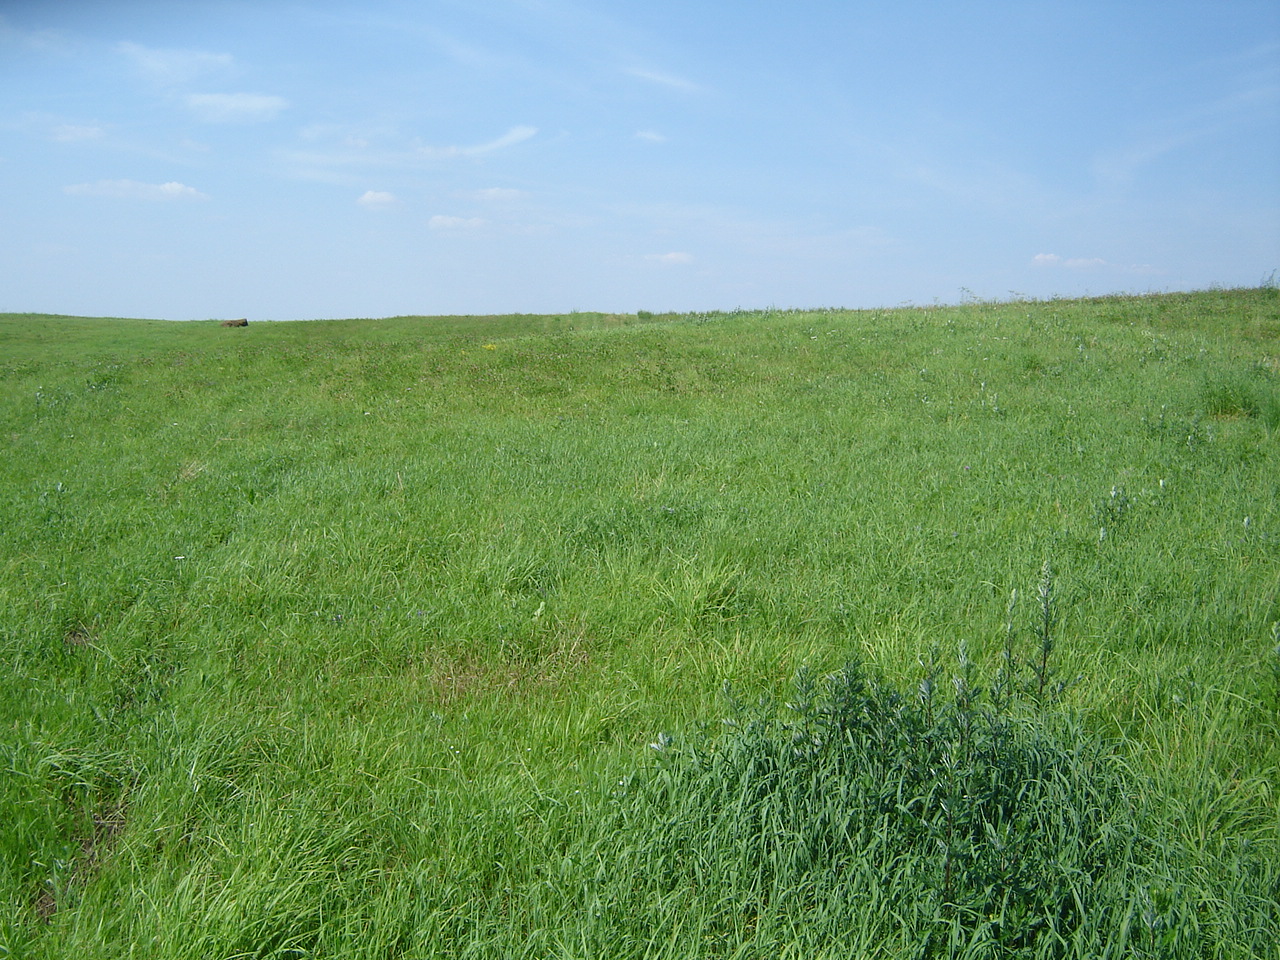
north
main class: Grassland
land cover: Grassland without tree/shrub cover
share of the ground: > 75 %
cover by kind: herbaceous plants 100 %
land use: Agriculture (excluding fallow land and kitchen gardens)
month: August
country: LT
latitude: 55.1553
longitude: 24.9743
